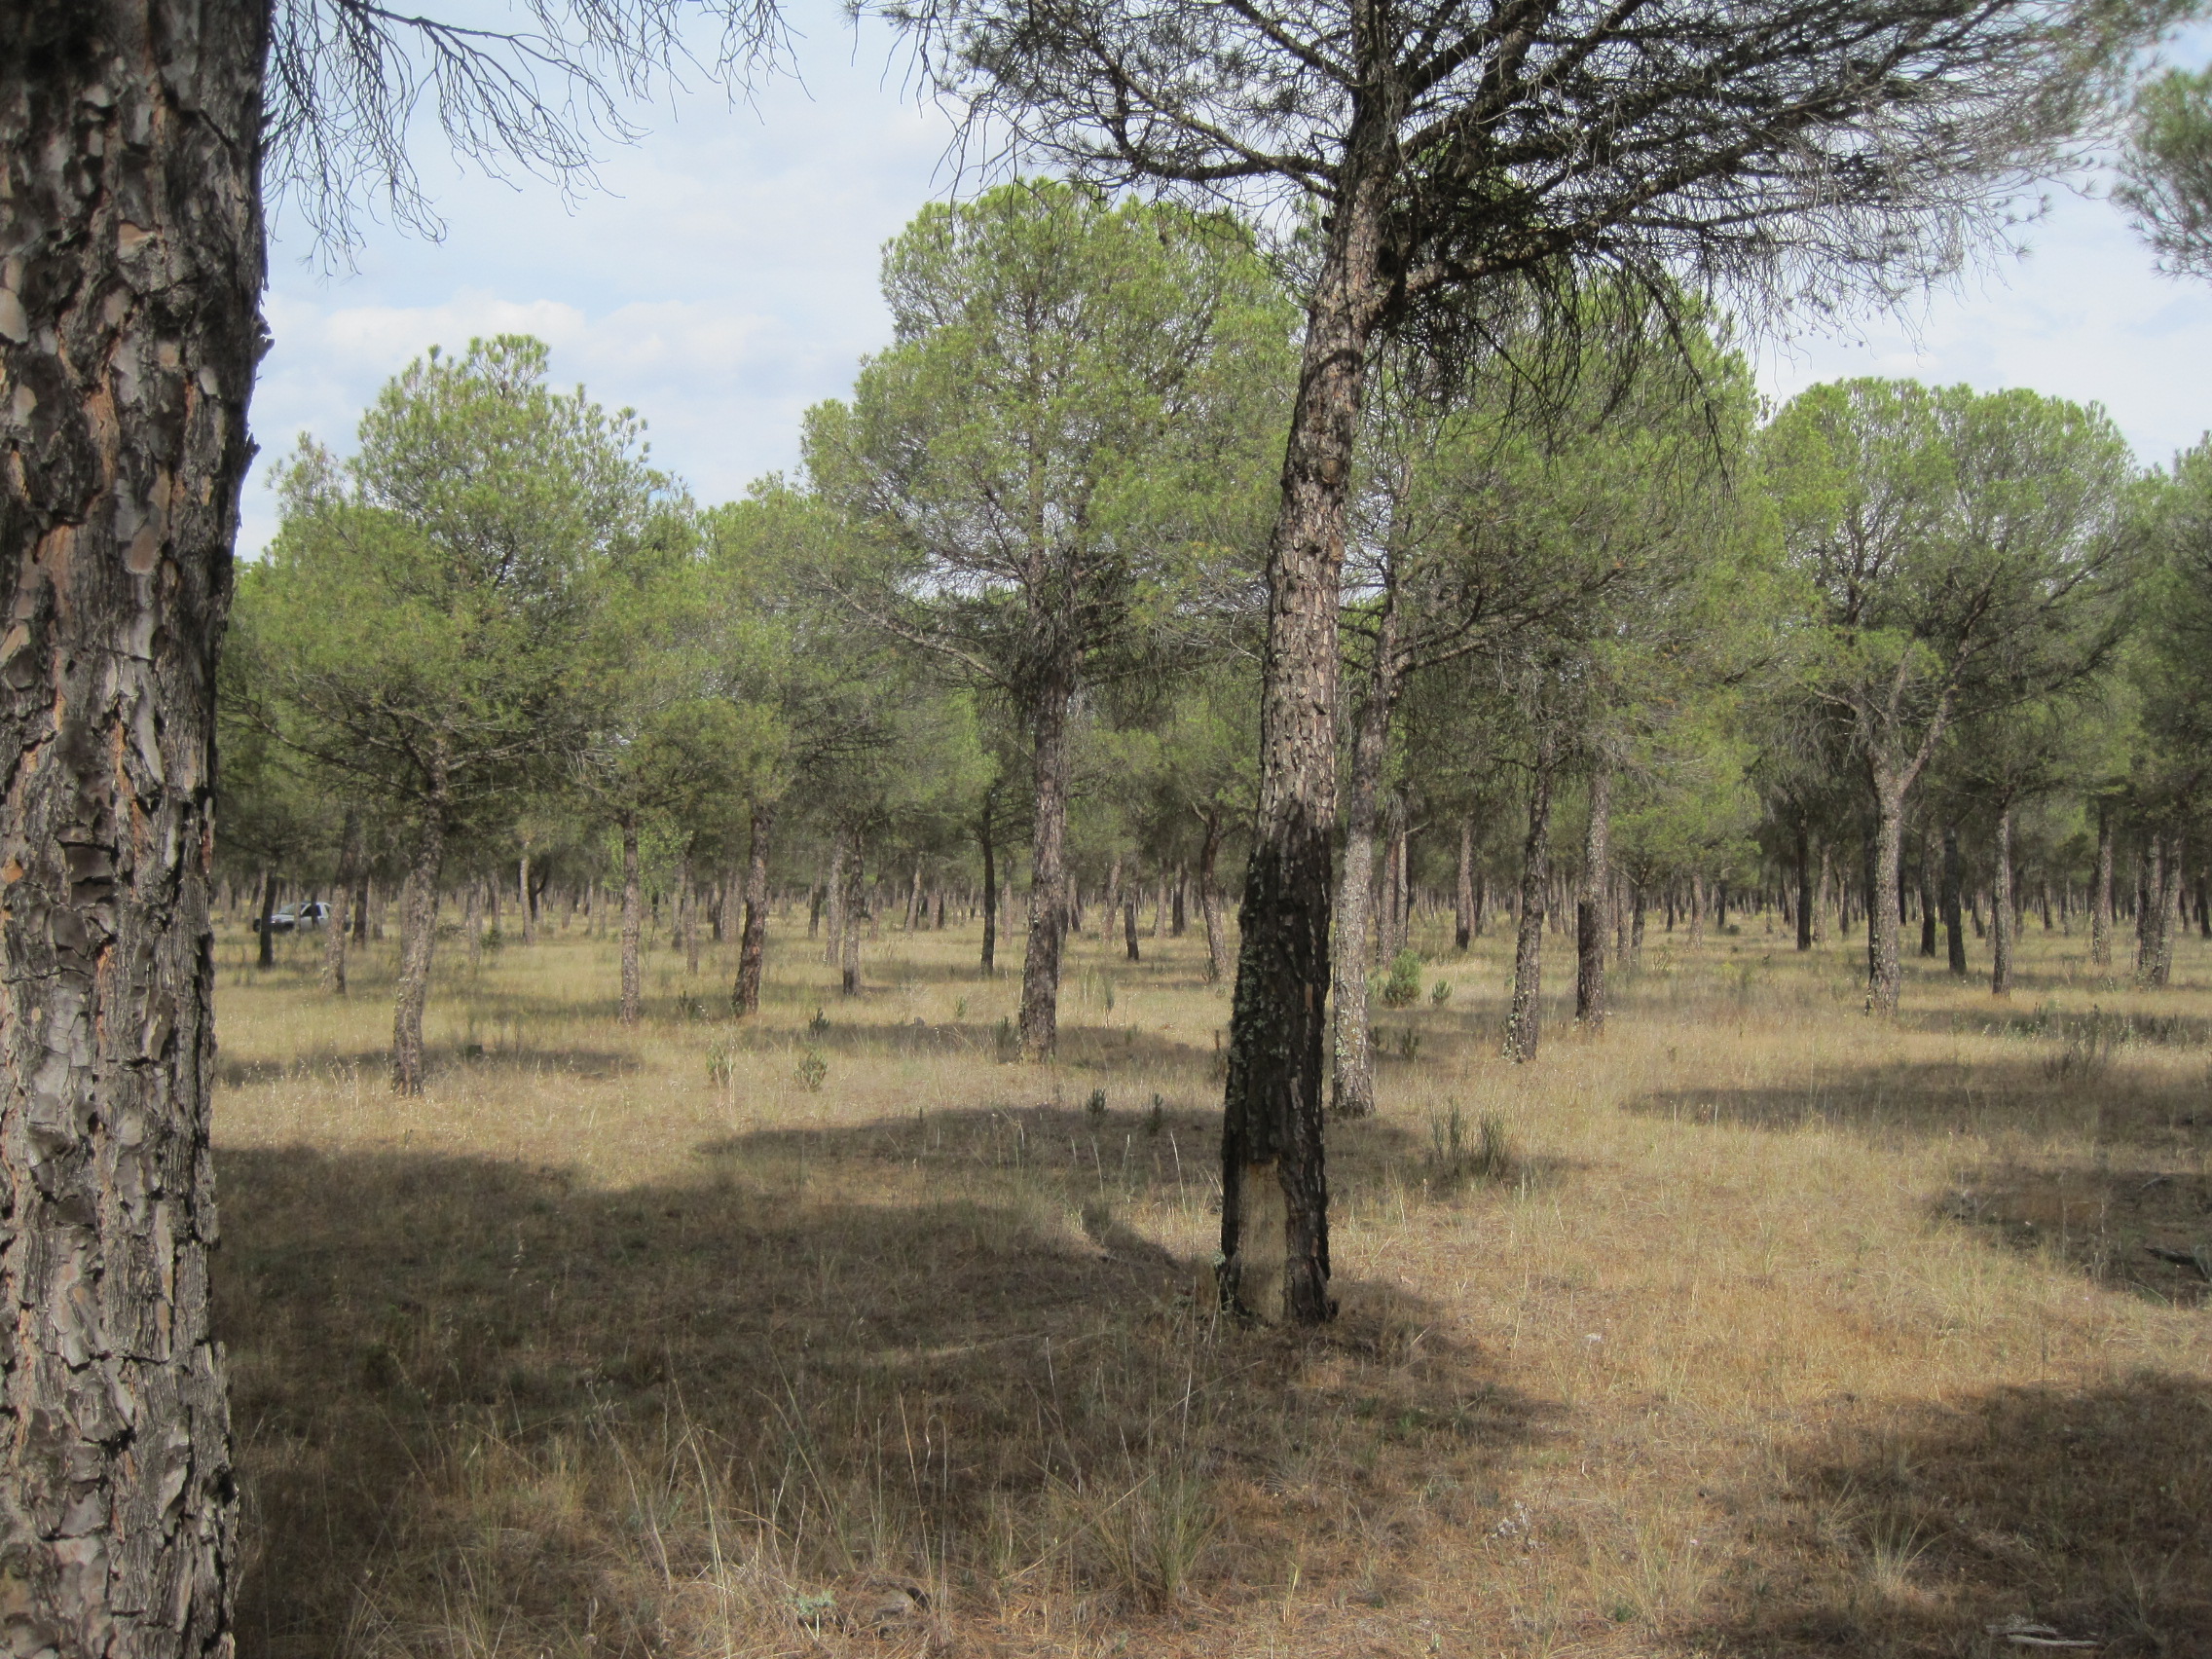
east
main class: Woodland
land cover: Pine dominated coniferous woodland
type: coniferous forest of the mediterranean region
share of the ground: 50 - 75 %
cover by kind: coniferous forest trees 70 %, herbaceous plants 30 %
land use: Forestry
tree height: > 5 m
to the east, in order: Pine dominated coniferous woodland; Tracks; Pine dominated coniferous woodland
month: June
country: ES
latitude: 41.4279
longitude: -5.0660
